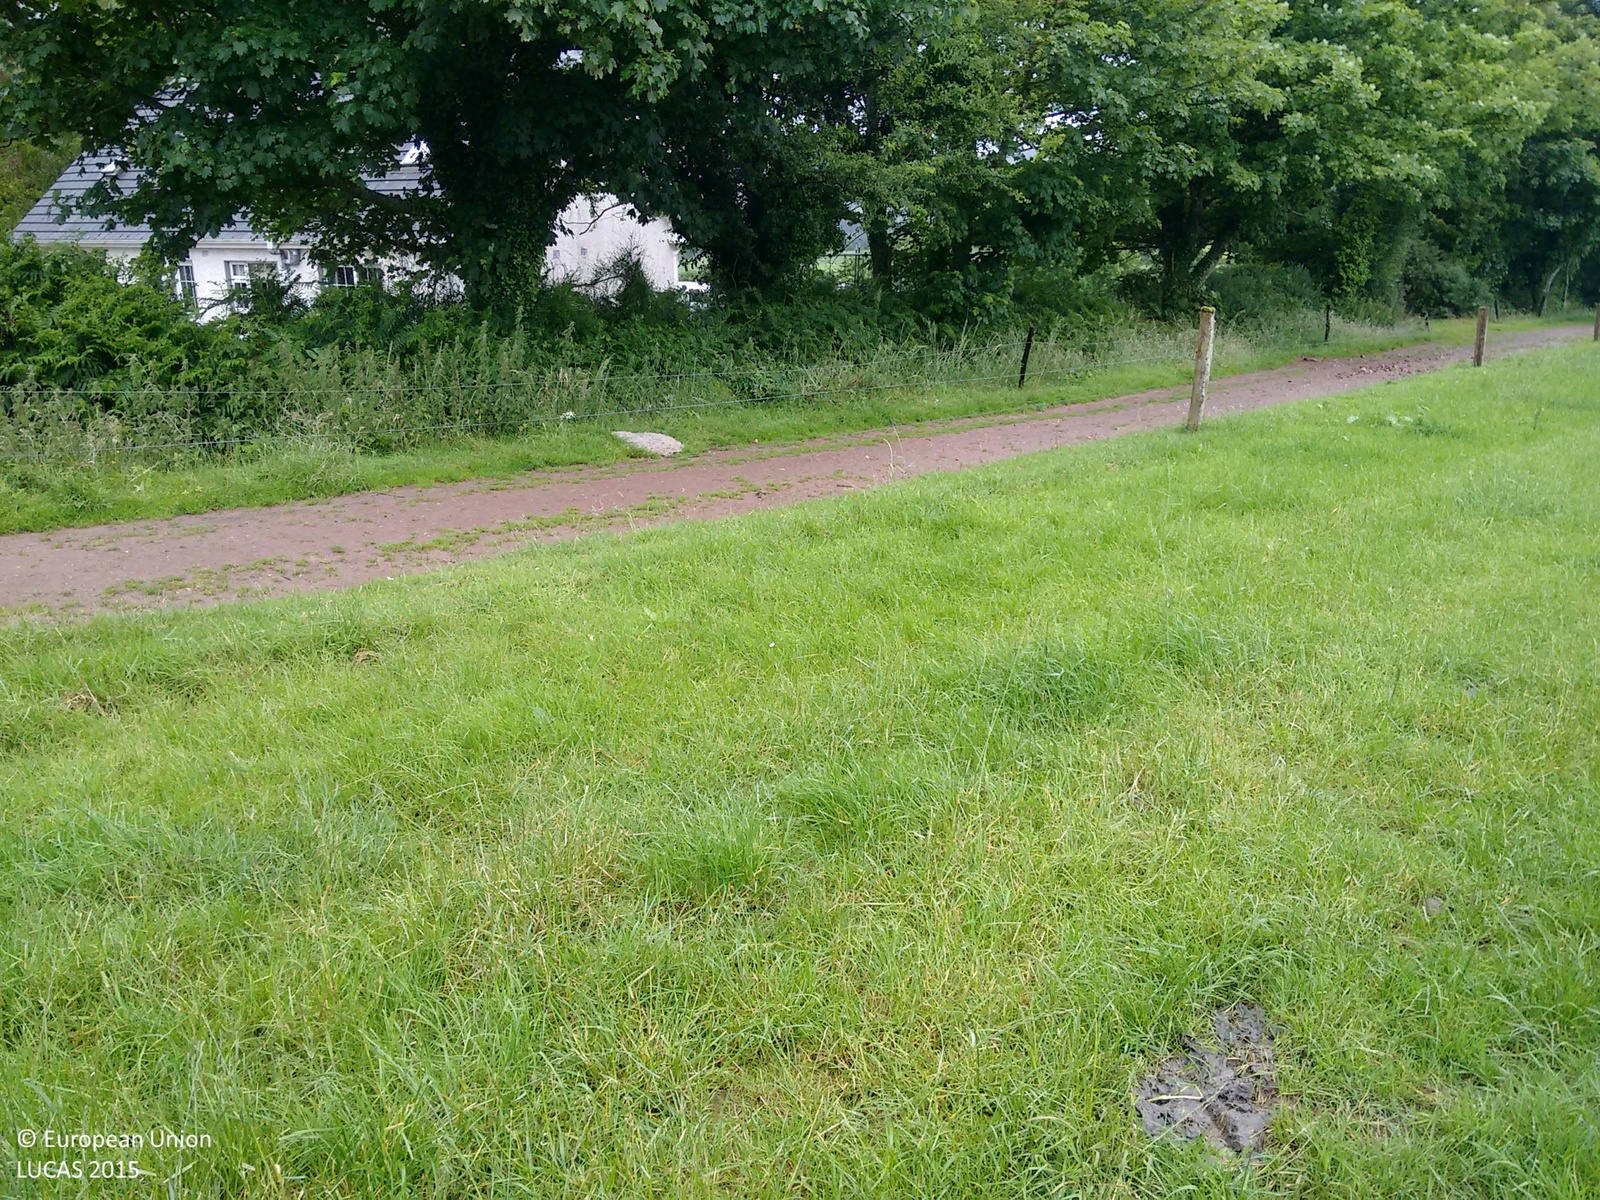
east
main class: Grassland
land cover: Grassland without tree/shrub cover
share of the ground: > 75 %
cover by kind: herbaceous plants 90 %, shrubs 5 %, unconsolidated bare surface 5 %
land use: Agriculture (excluding fallow land and kitchen gardens)
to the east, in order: Grassland without tree/shrub cover; Fences; Tracks; Grass margins; Fences; Ditches and canals; Abandoned hedges; Artificial constructions in urban areas; Lines of trees; Tracks; Grassland without tree/shrub cover; Fences; Grassland without tree/shrub cover; Fences; Grassland without tree/shrub cover
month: July
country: IE
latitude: 52.1910
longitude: -8.1902
